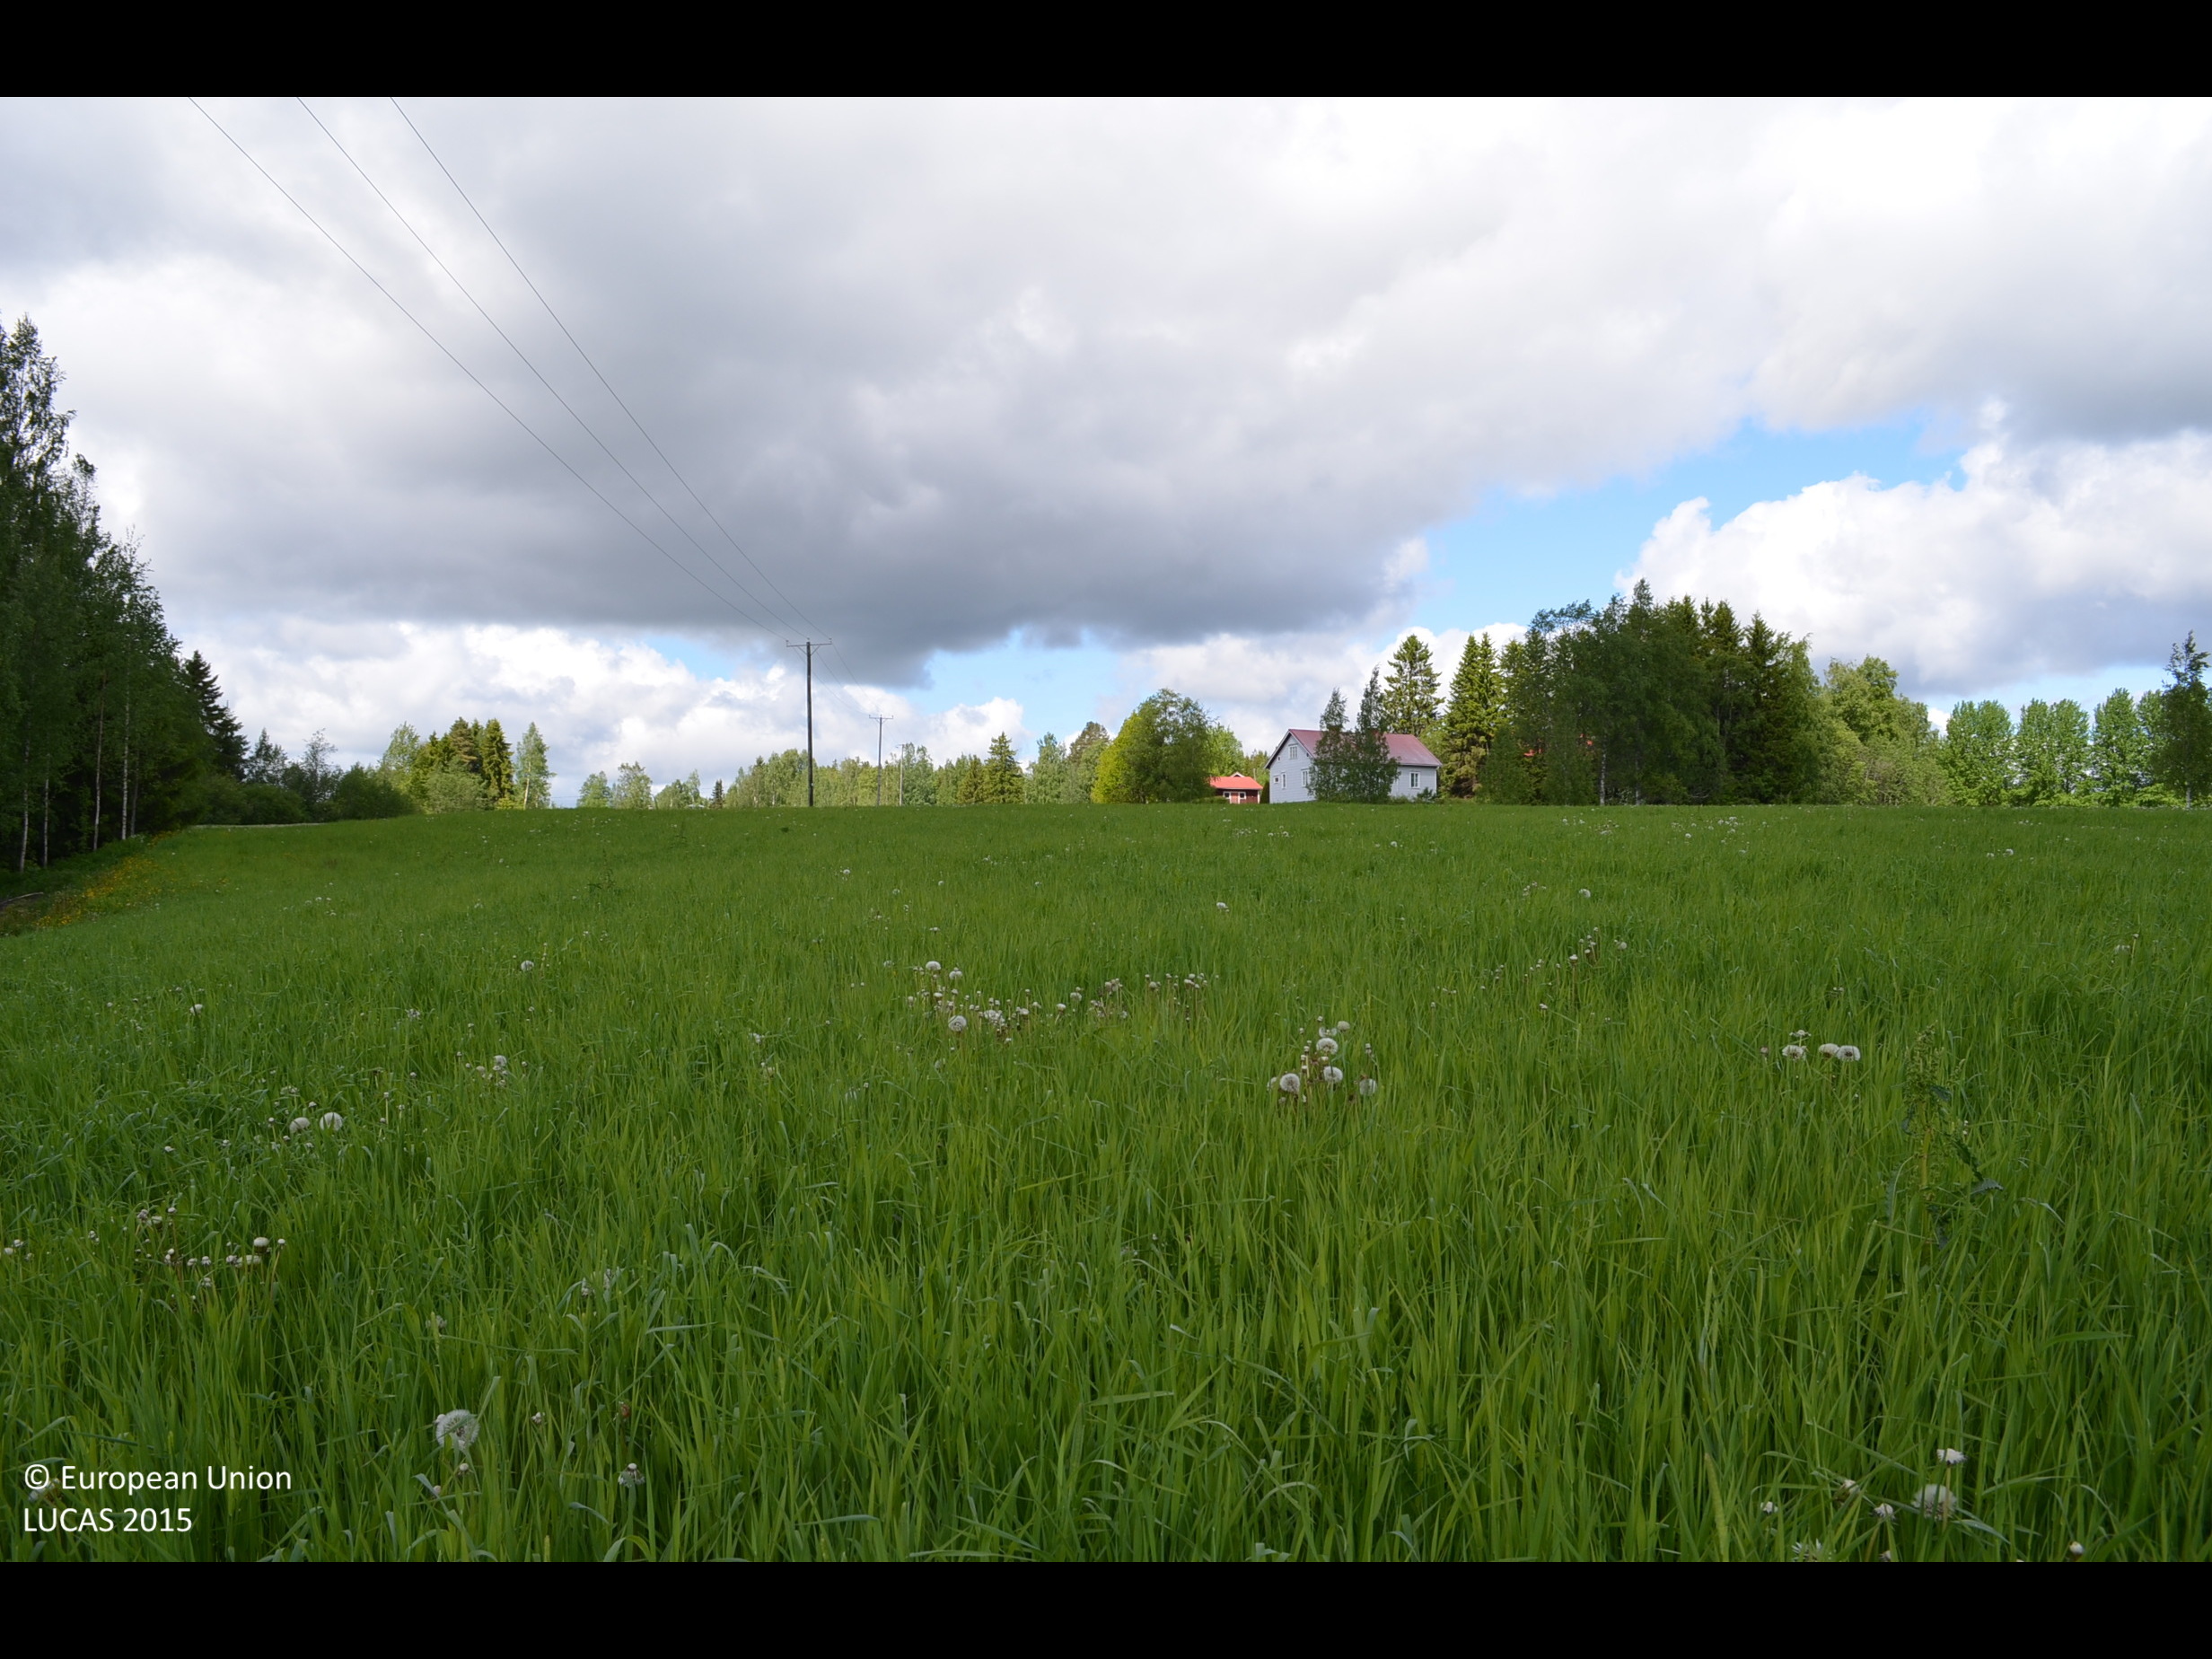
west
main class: Cropland
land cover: Temporary grasslands
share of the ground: > 75 %
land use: Agriculture (excluding fallow land and kitchen gardens)
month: June
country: FI
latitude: 61.8747
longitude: 22.8636
